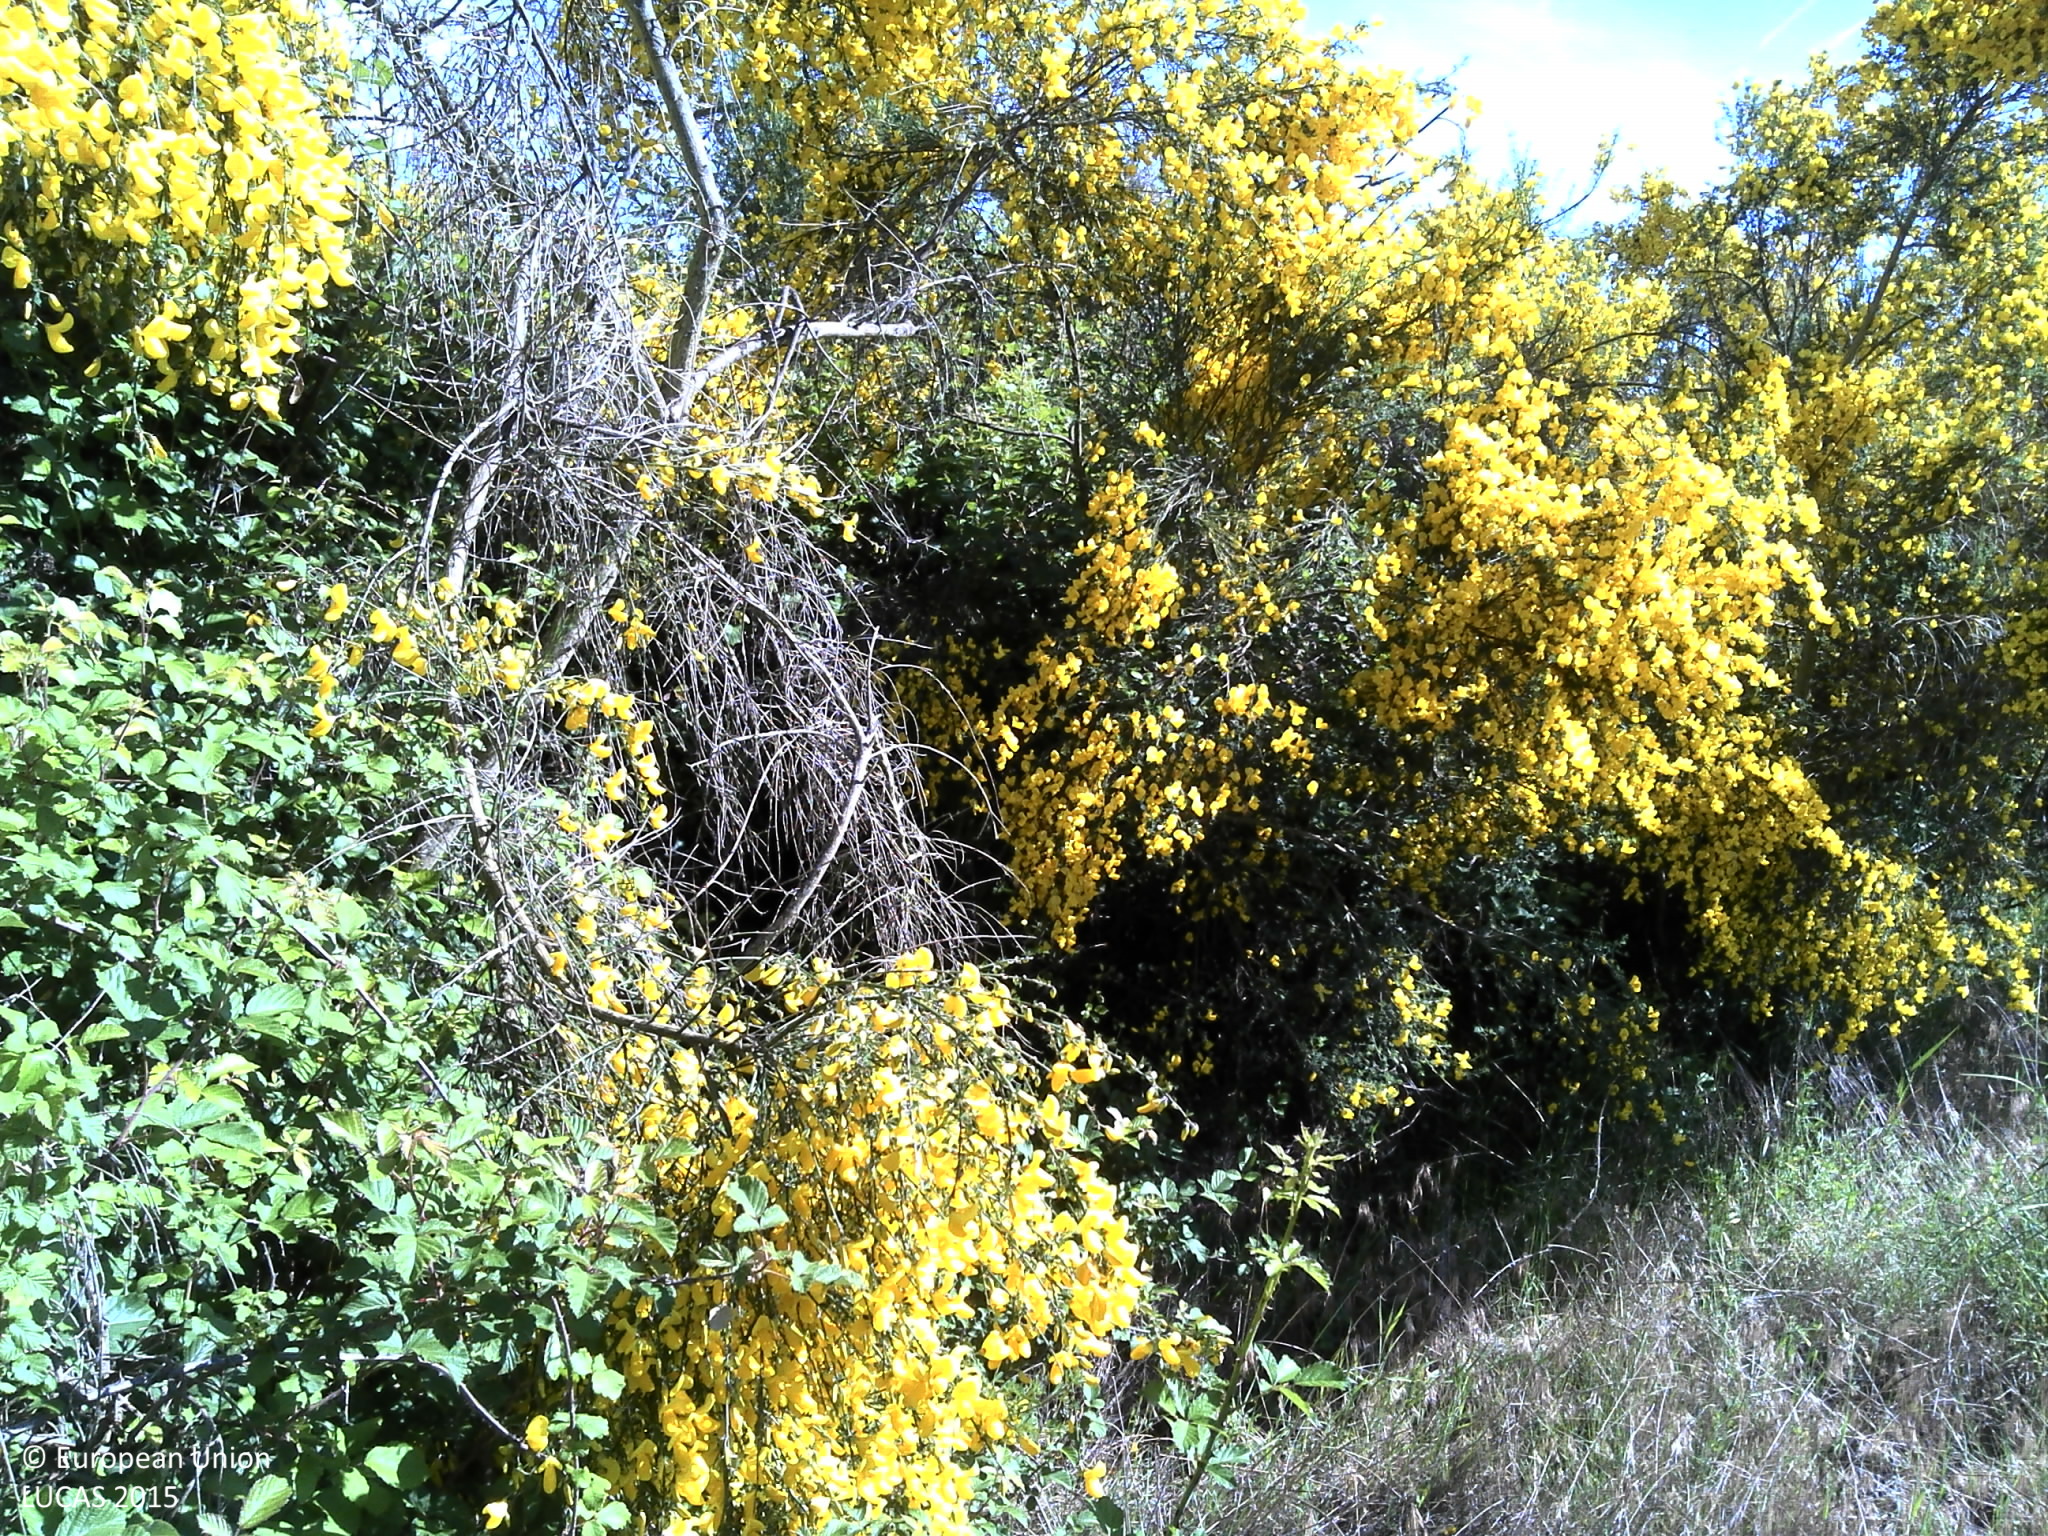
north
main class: Shrubland
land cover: Shrubland without tree cover
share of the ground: 25 - 50 %
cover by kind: herbaceous plants 70 %, shrubs 30 %
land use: Forestry
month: May
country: PT
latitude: 41.7671
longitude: -7.3654
